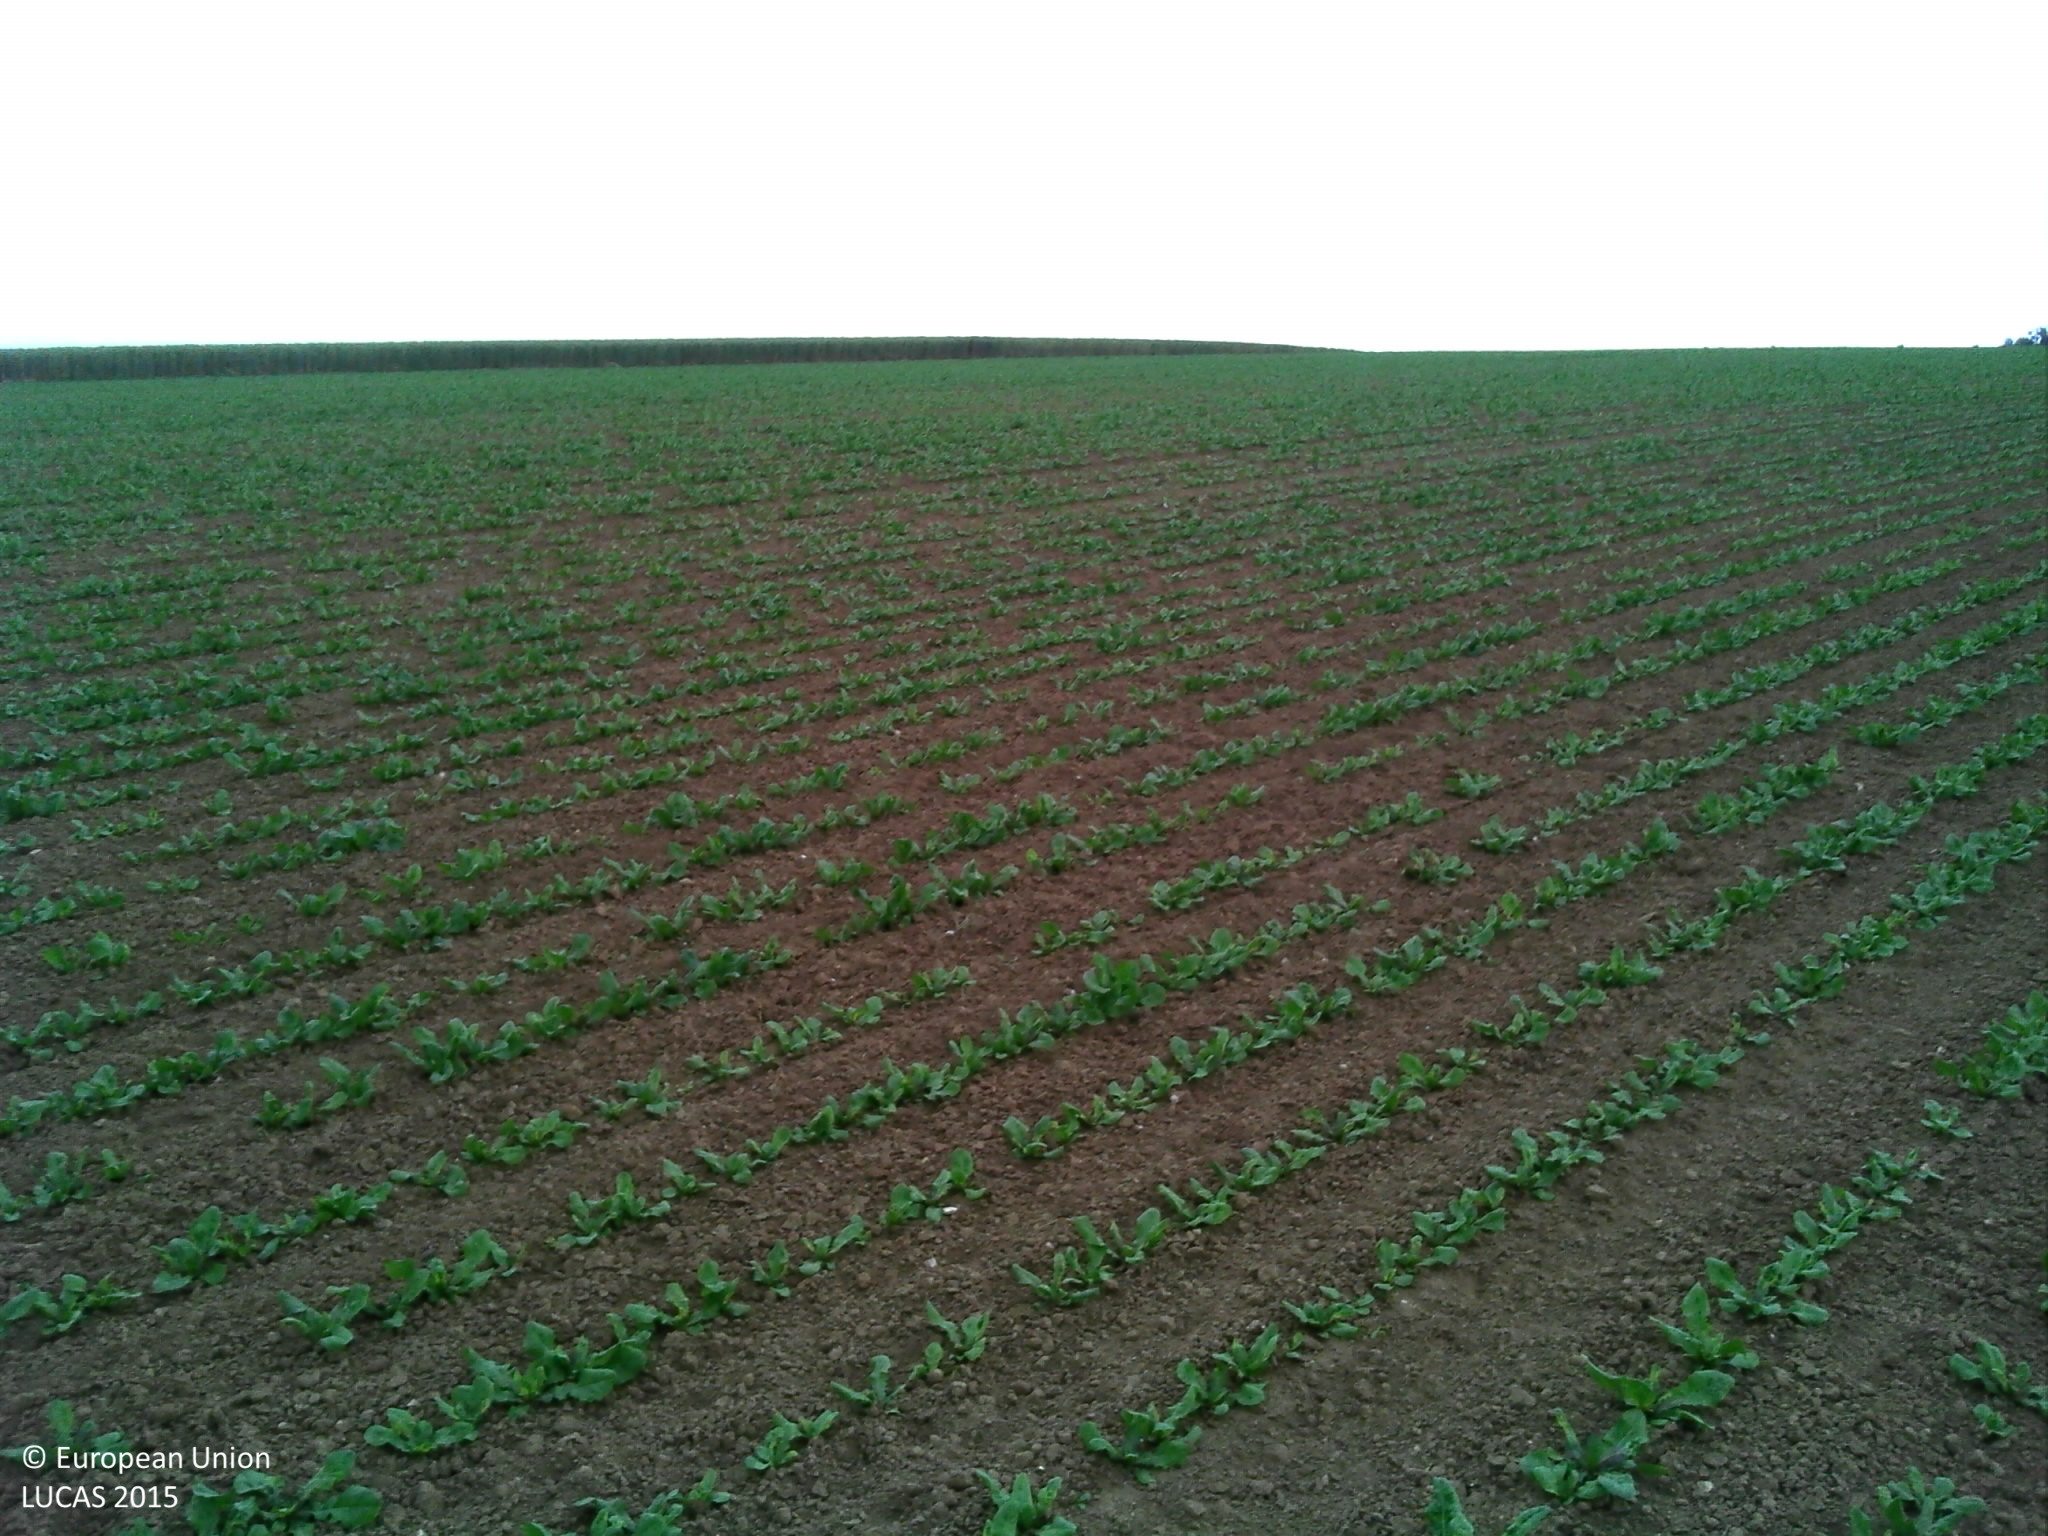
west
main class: Cropland
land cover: Other fresh vegetables
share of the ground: 10 - 25 %
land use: Agriculture (excluding fallow land and kitchen gardens)
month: July
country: FR
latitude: 50.4508
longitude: 2.0839
